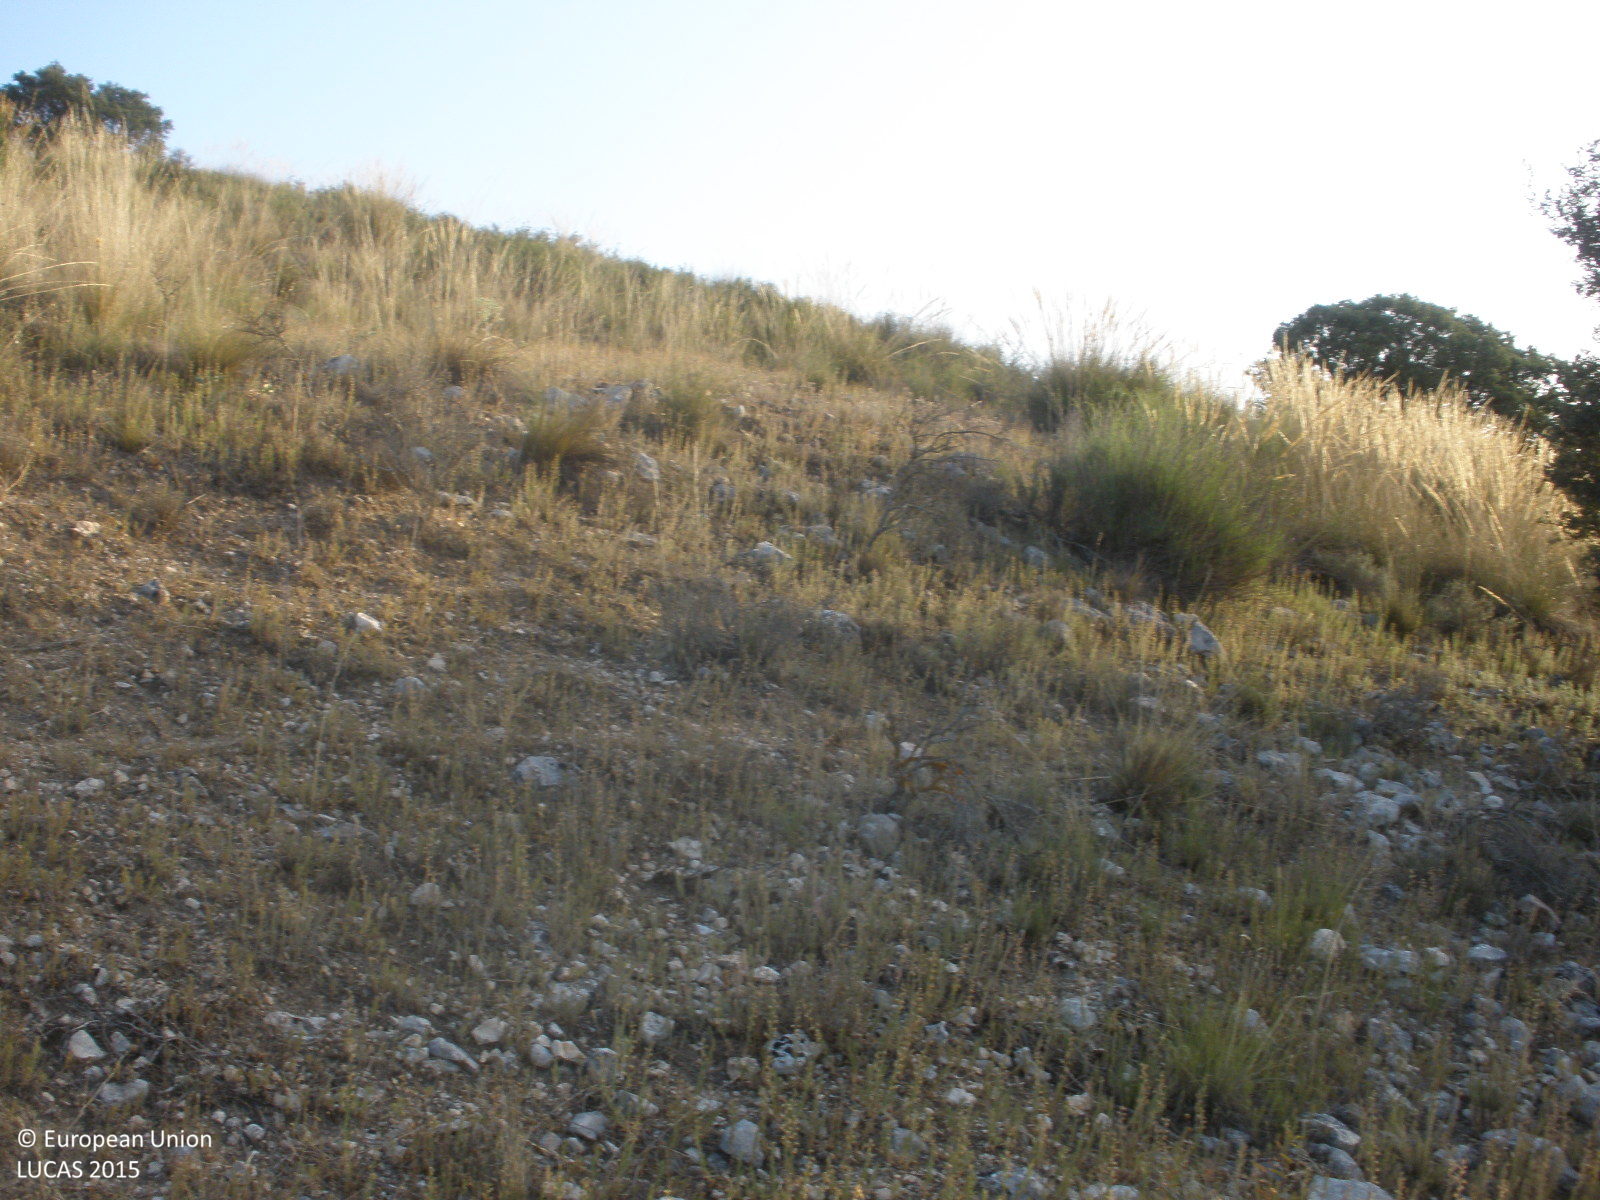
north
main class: Shrubland
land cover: Shrubland without tree cover
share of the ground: 25 - 50 %
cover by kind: herbaceous plants 50 %, shrubs 40 %, consolidated bare surface 10 %
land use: Semi-natural and natural areas not in use
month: July
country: ES
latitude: 40.1733
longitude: -3.3583
